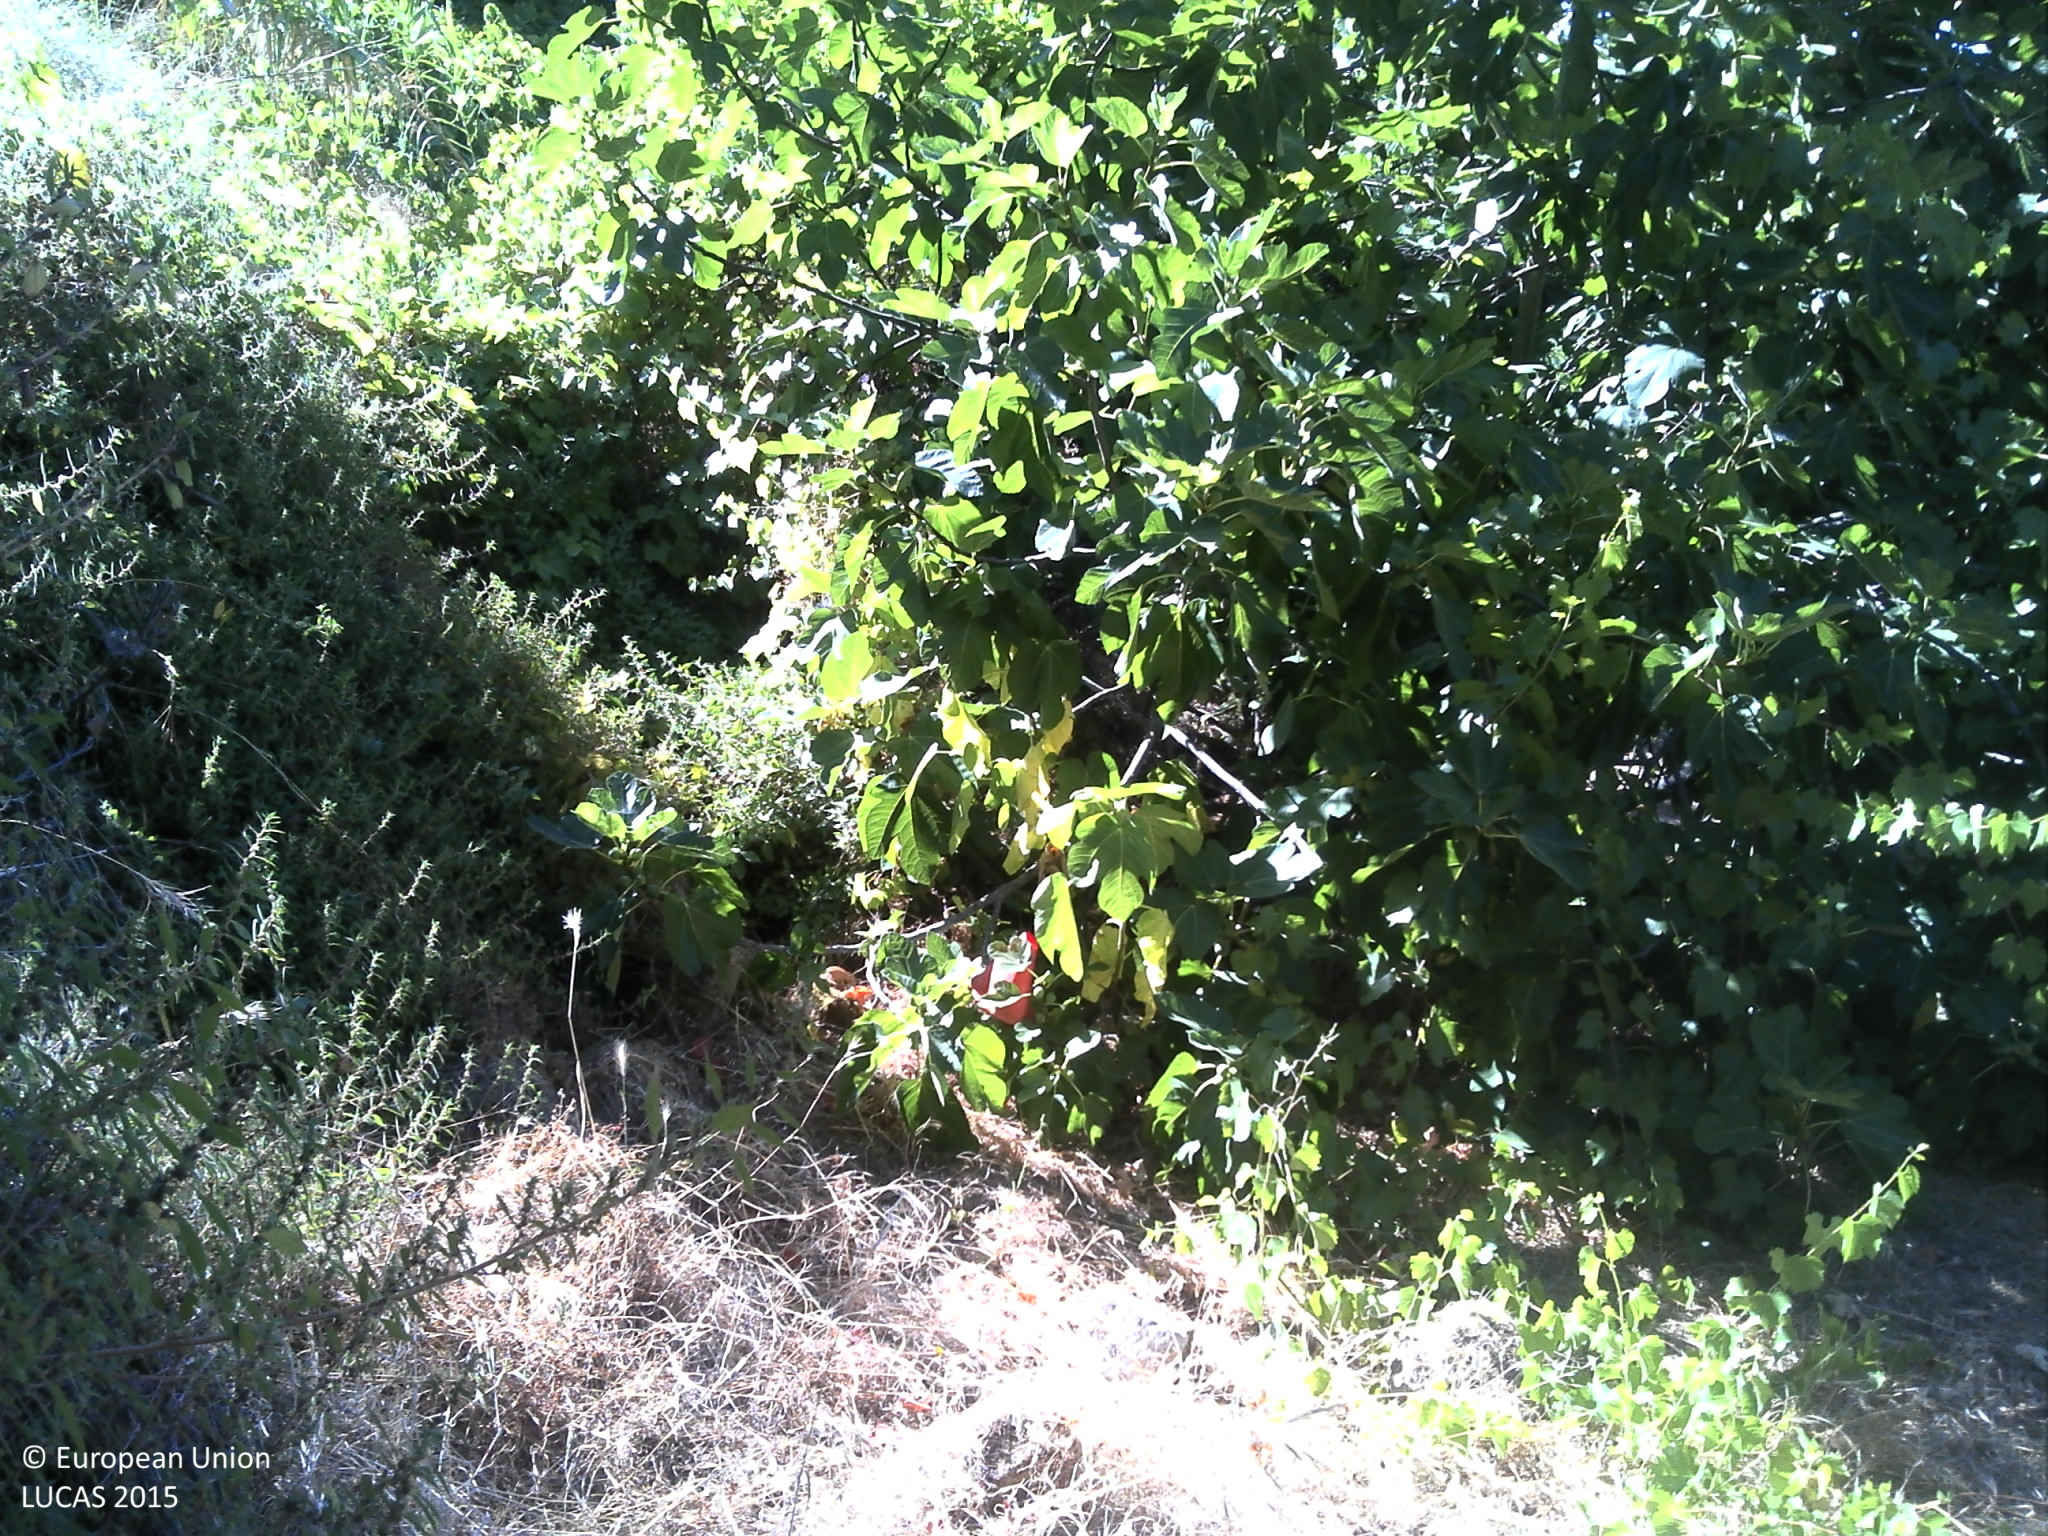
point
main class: Cropland
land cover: Olive groves
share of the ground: < 10 %
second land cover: Grassland without tree/shrub cover
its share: > 75 %
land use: Agriculture (excluding fallow land and kitchen gardens)
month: July
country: PT
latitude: 41.3038
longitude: -7.3794
